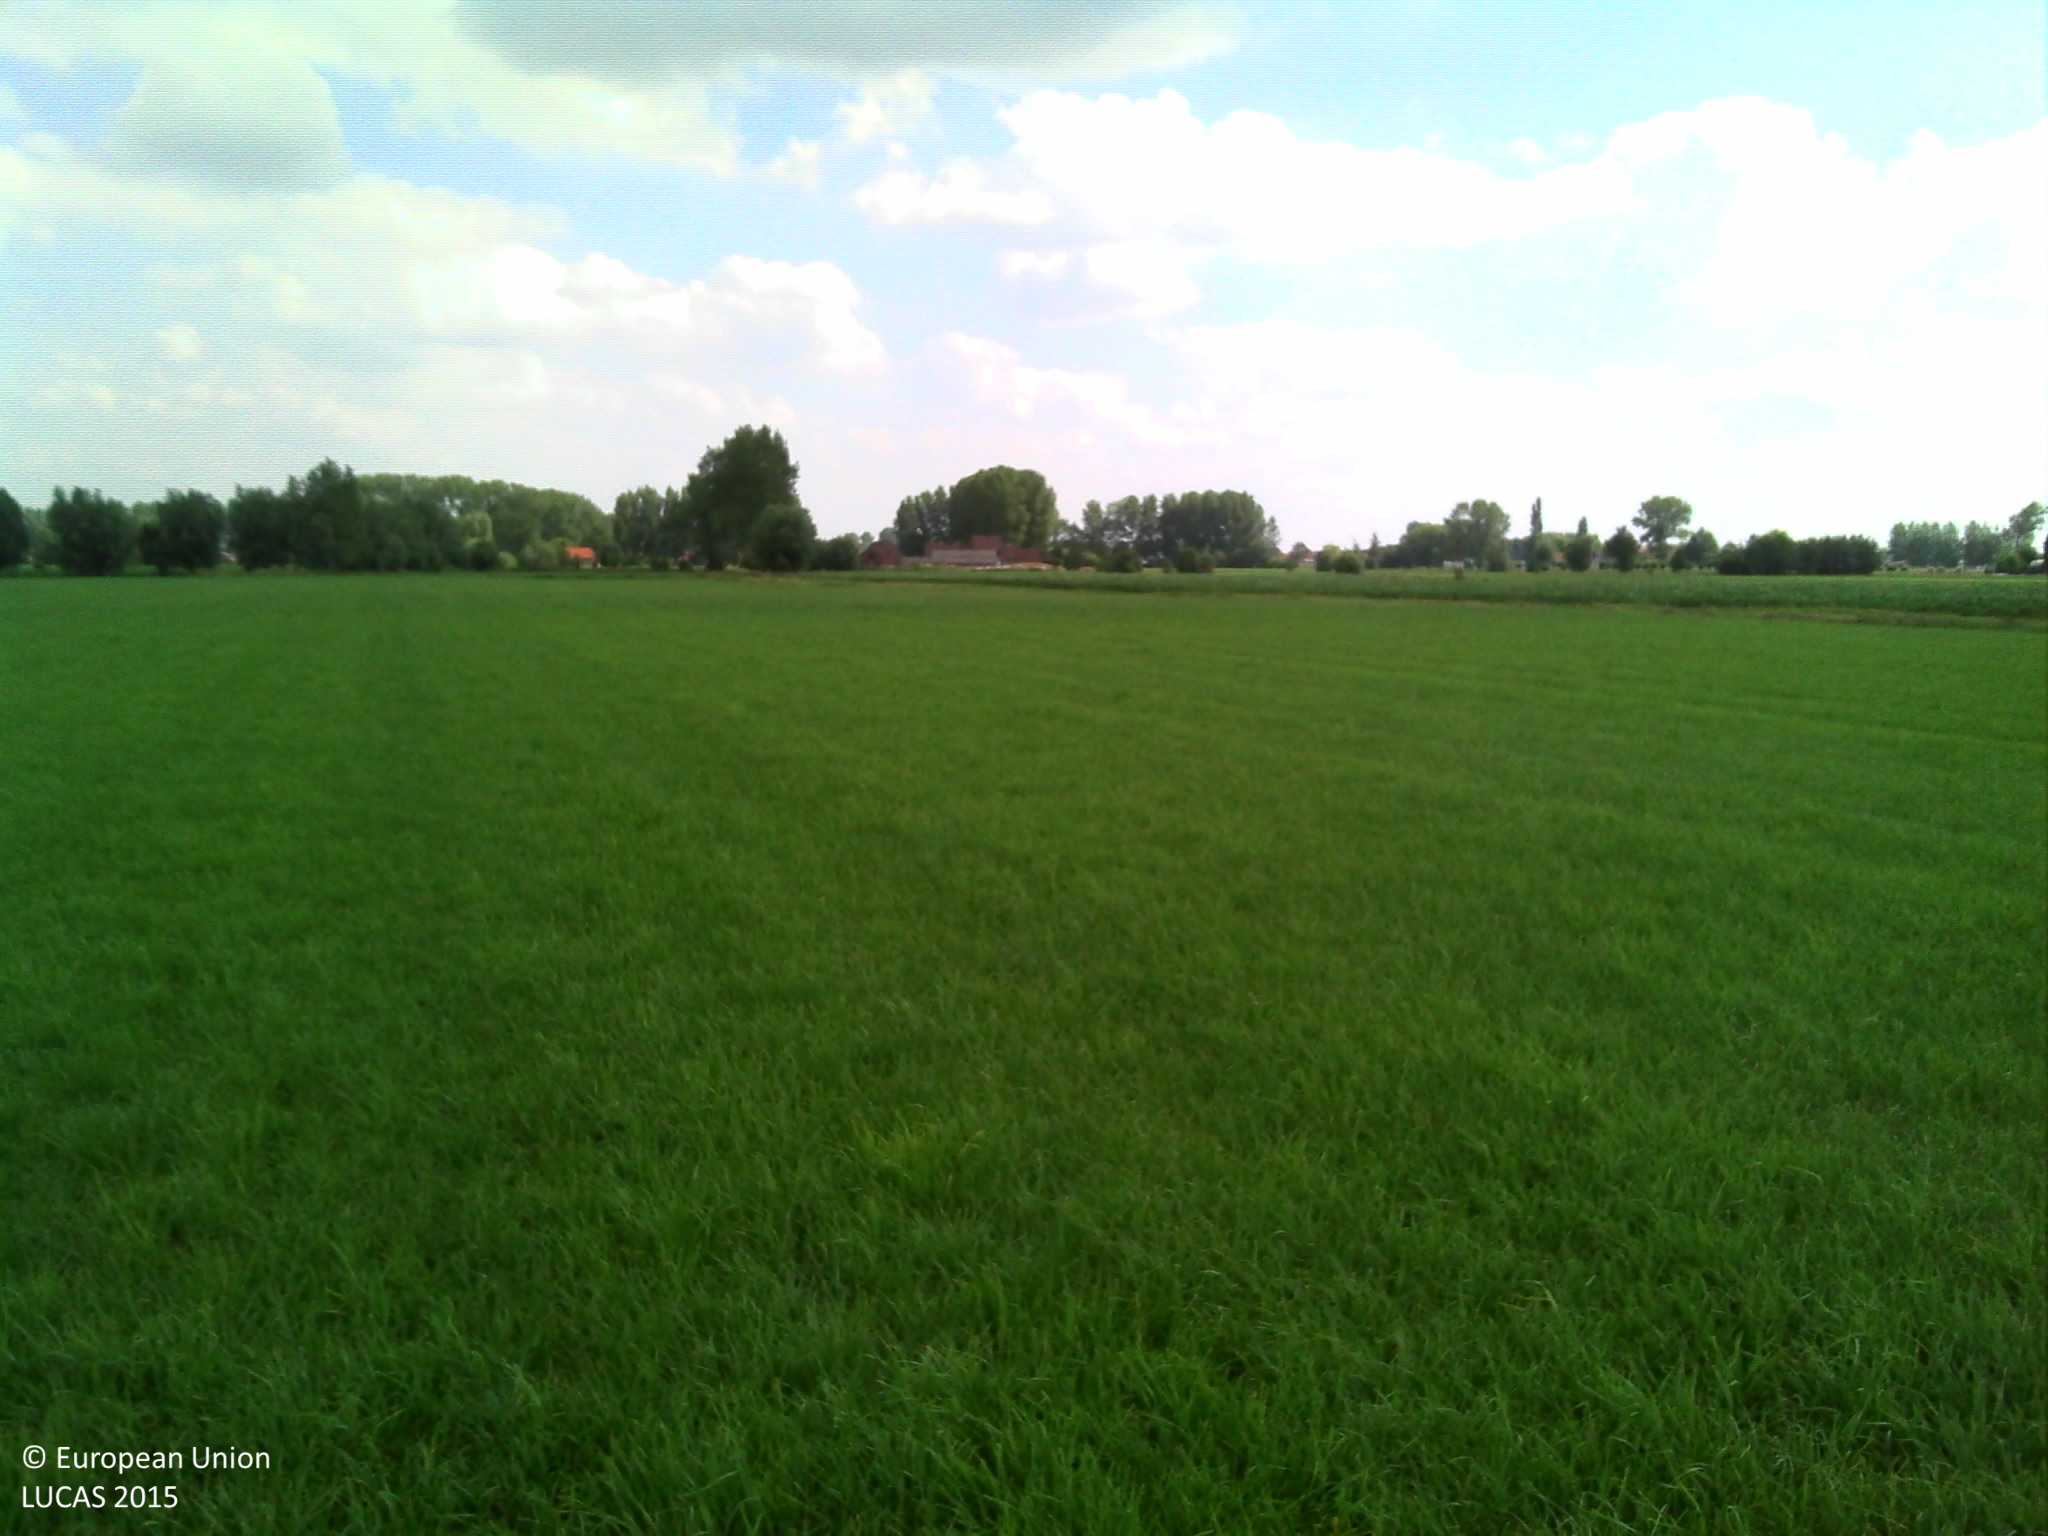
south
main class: Cropland
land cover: Temporary grasslands
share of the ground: > 75 %
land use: Agriculture (excluding fallow land and kitchen gardens)
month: June
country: BE
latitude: 51.1011
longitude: 3.8672
